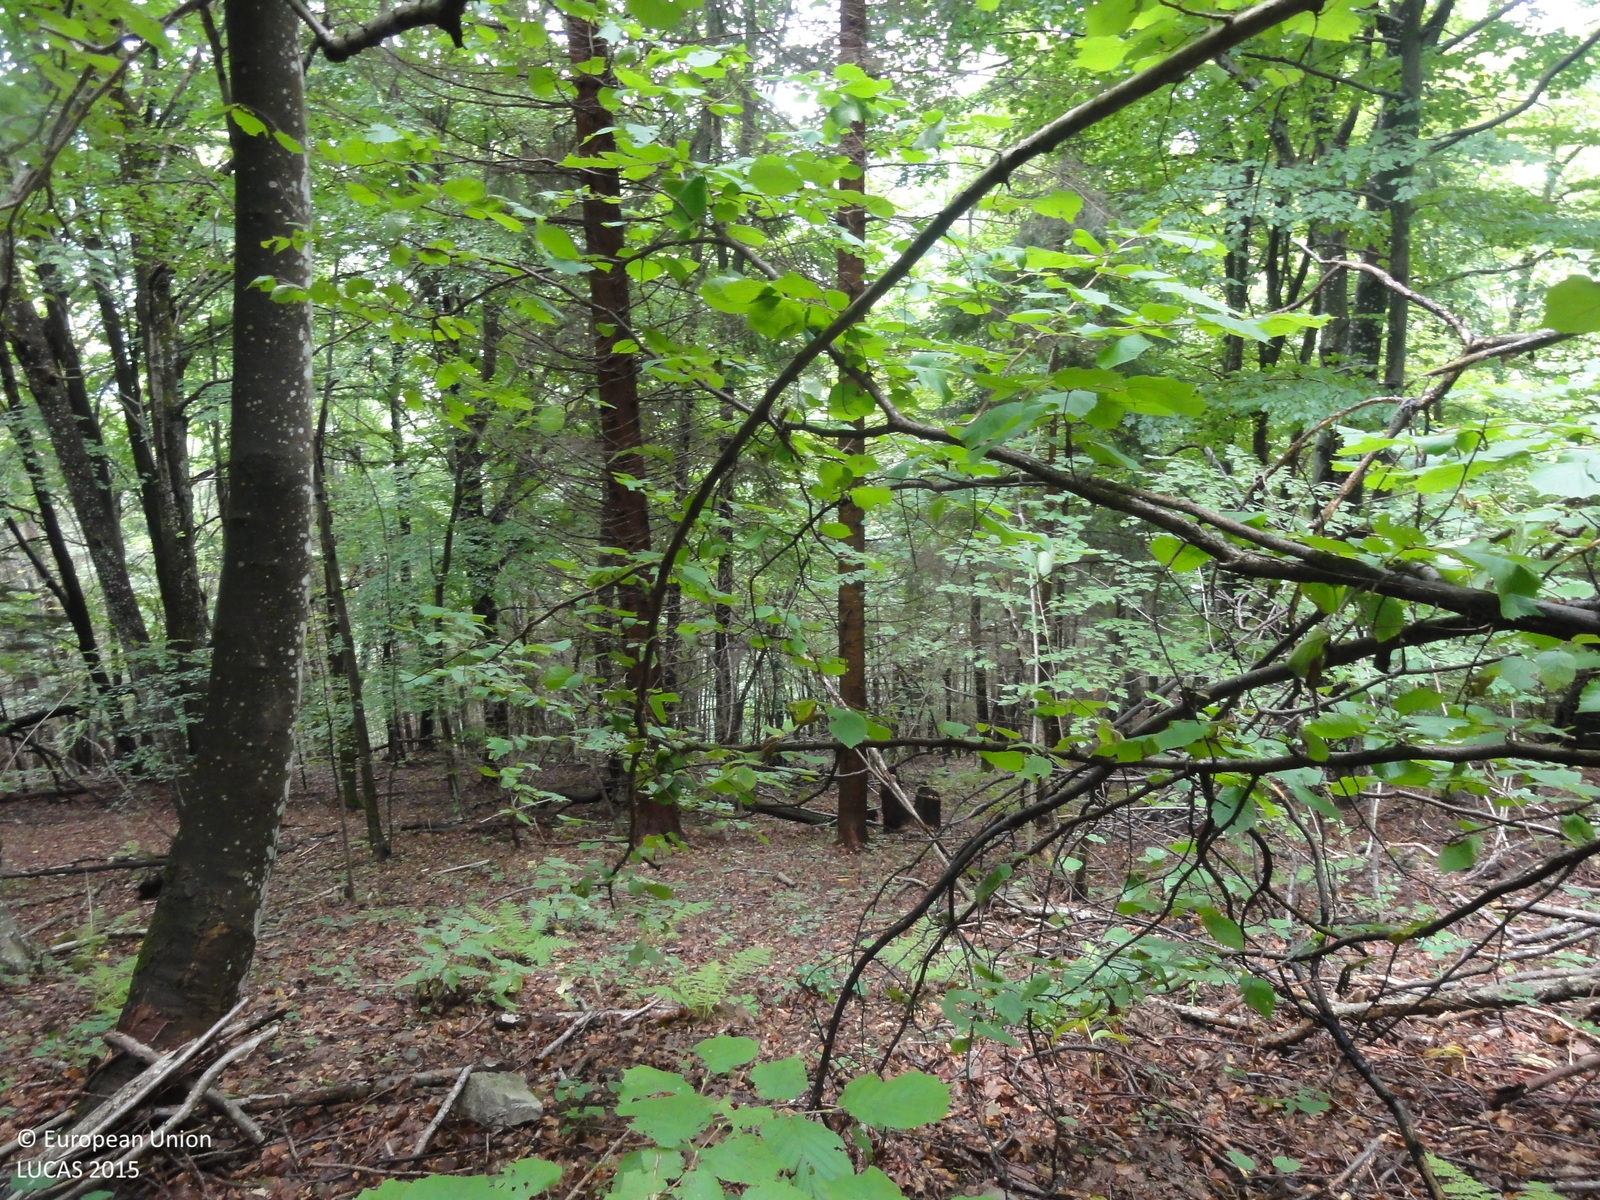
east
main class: Woodland
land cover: Broadleaved woodland
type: beech forest
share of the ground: > 75 %
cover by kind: broadleaved forest trees 90 %, coniferous forest trees 10 %
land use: Forestry
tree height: > 5 m
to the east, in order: Broadleaved woodland; Spruce dominated mixed woodland; Spruce dominated coniferous woodland; Spruce dominated mixed woodland
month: August
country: SI
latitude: 45.6704
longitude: 15.0922
